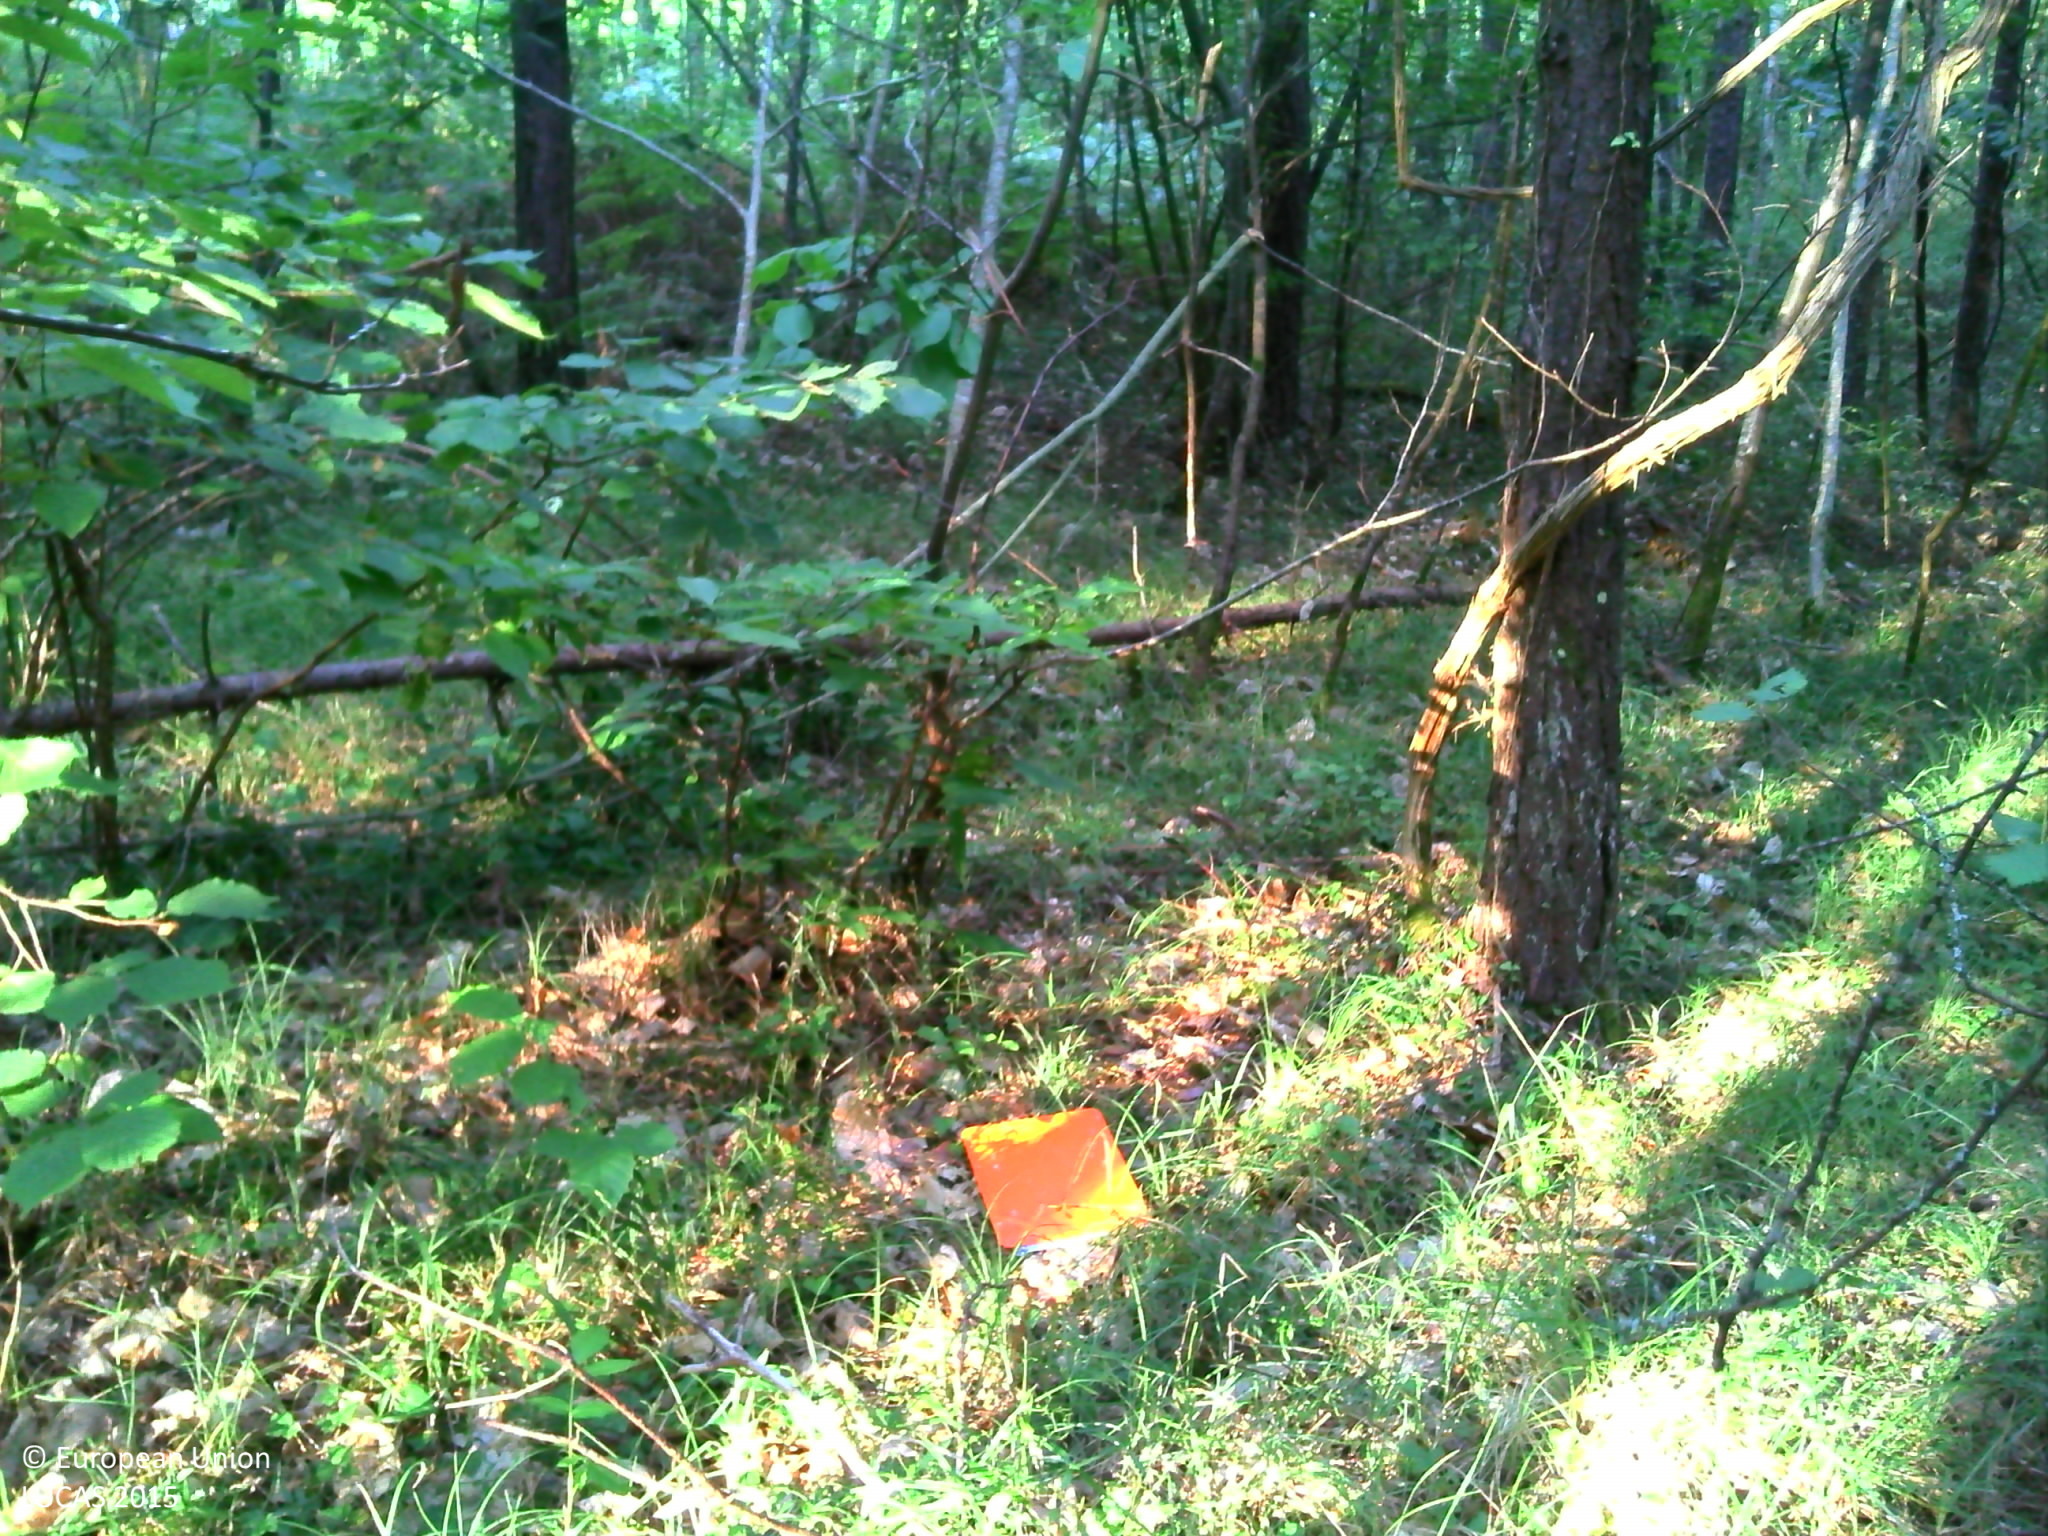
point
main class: Woodland
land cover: Pine dominated mixed woodland
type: mesophytic deciduous forest
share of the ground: > 75 %
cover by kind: broadleaved forest trees 60 %, coniferous forest trees 20 %, herbaceous plants 10 %, shrubs 5 %, lichens and mosses 5 %
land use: Forestry
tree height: > 5 m
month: August
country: FR
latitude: 44.8297
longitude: 0.7970
